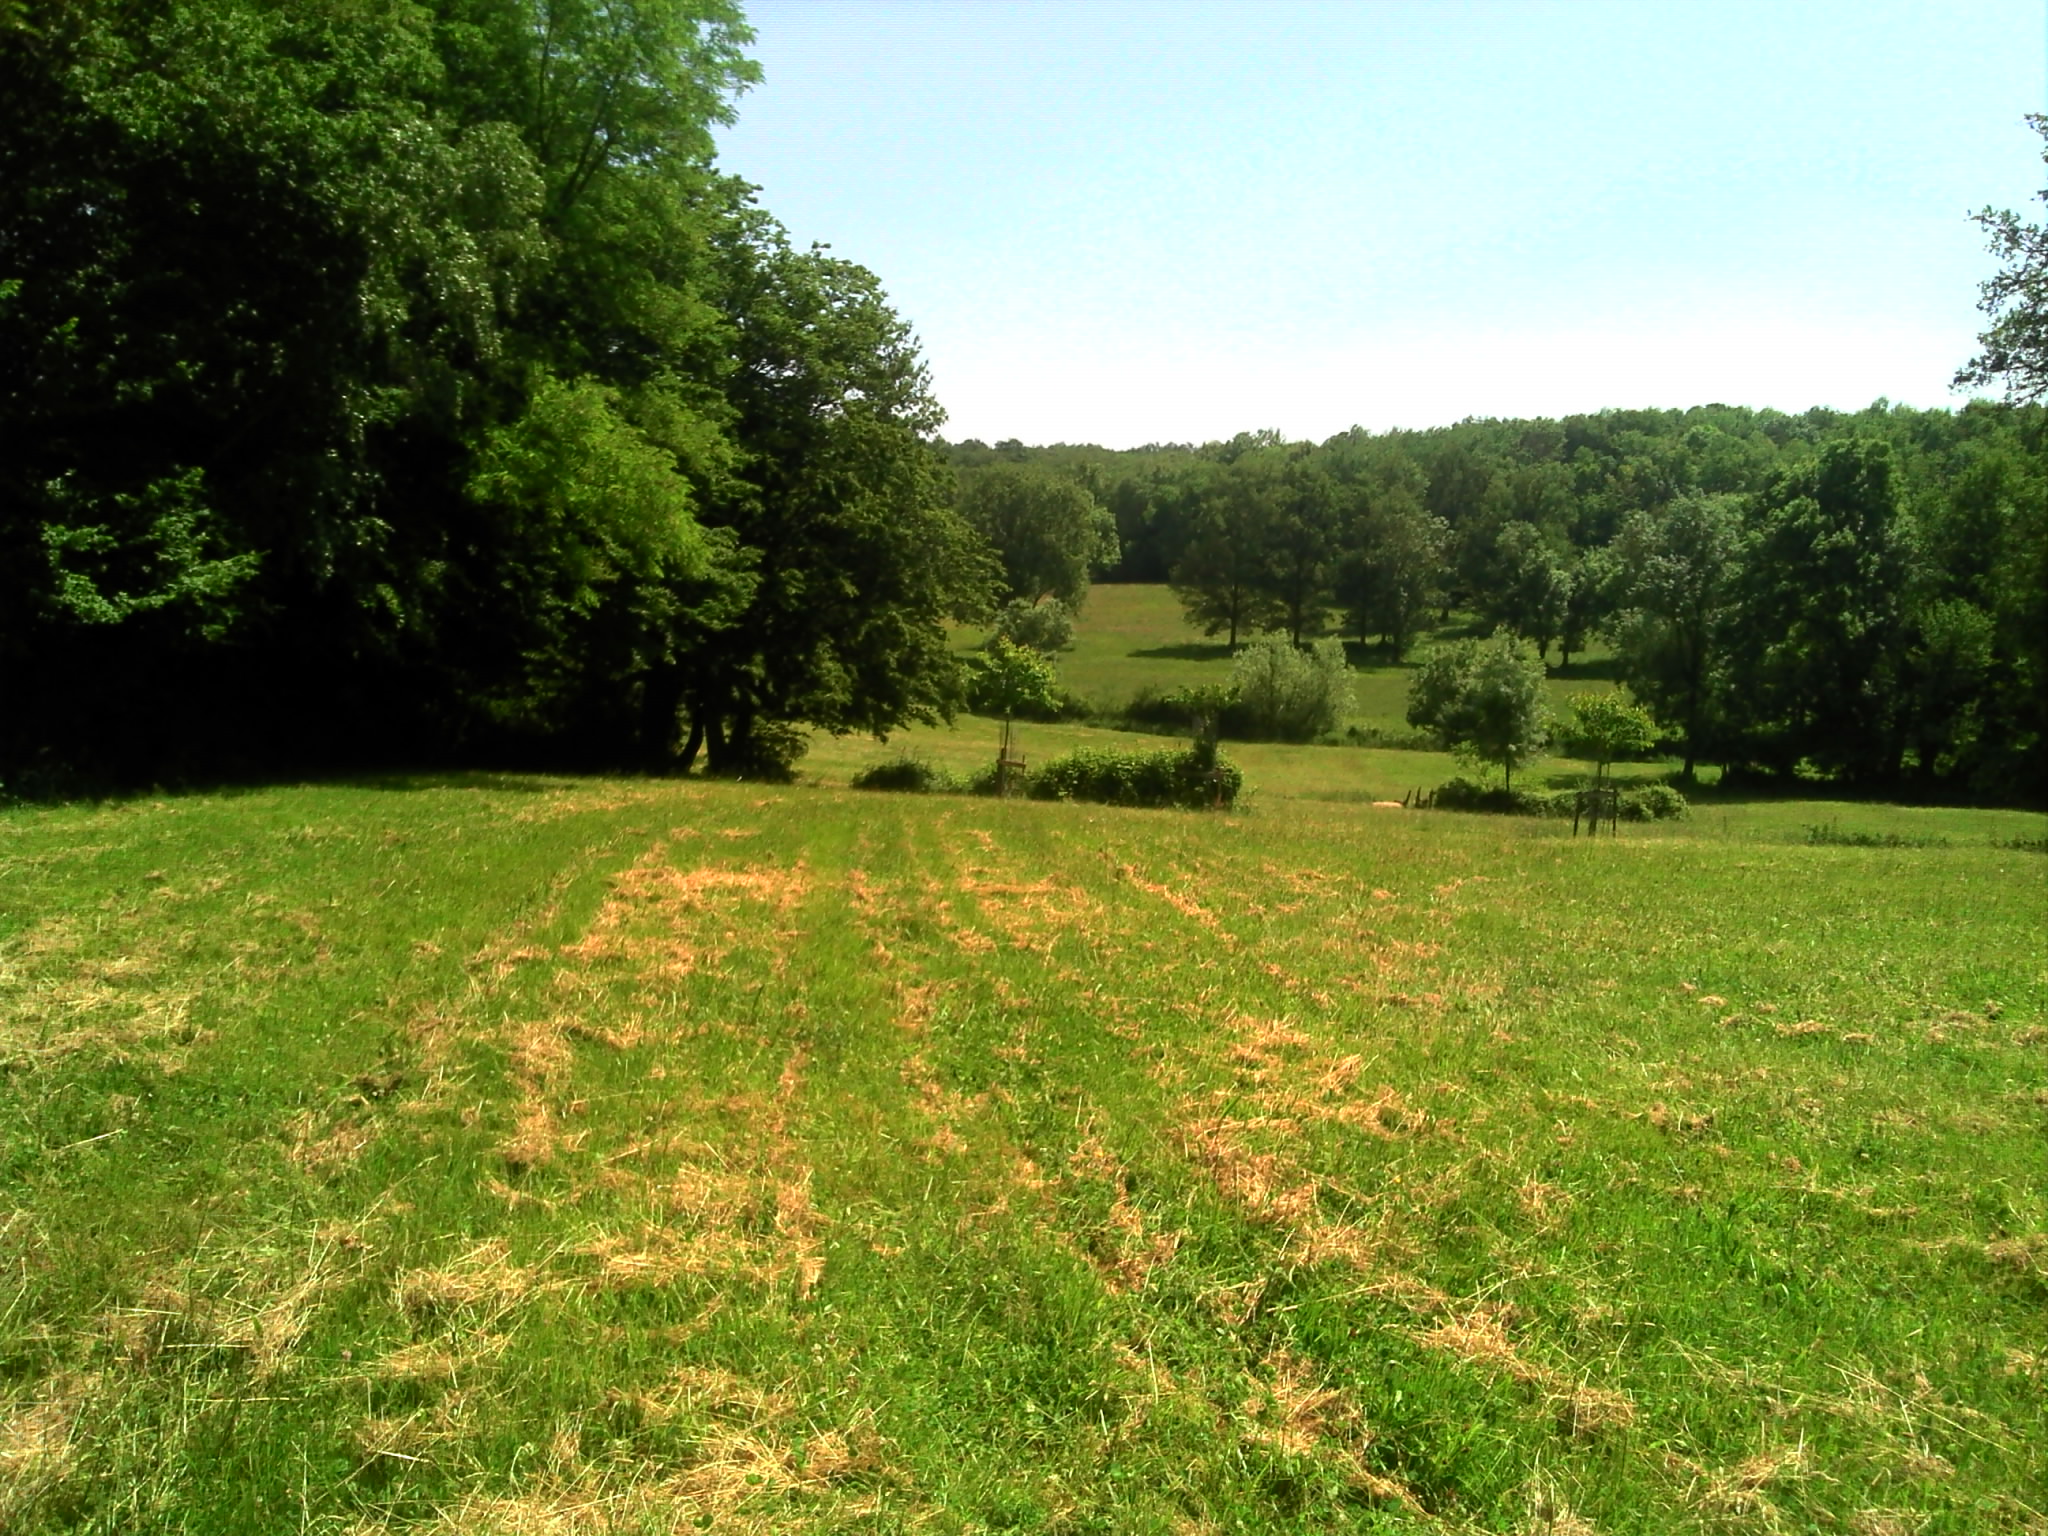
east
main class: Grassland
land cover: Grassland without tree/shrub cover
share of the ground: > 75 %
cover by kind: herbaceous plants 100 %
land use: Agriculture (excluding fallow land and kitchen gardens)
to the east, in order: Grassland without tree/shrub cover; Lines of trees; Grassland without tree/shrub cover; Abandoned hedges; Grassland without tree/shrub cover; Inland fresh running water; Grassland without tree/shrub cover; Managed hedges; Grassland without tree/shrub cover; Single bushes/trees; Grassland without tree/shrub cover
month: May
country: FR
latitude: 46.5282
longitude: 5.1133
